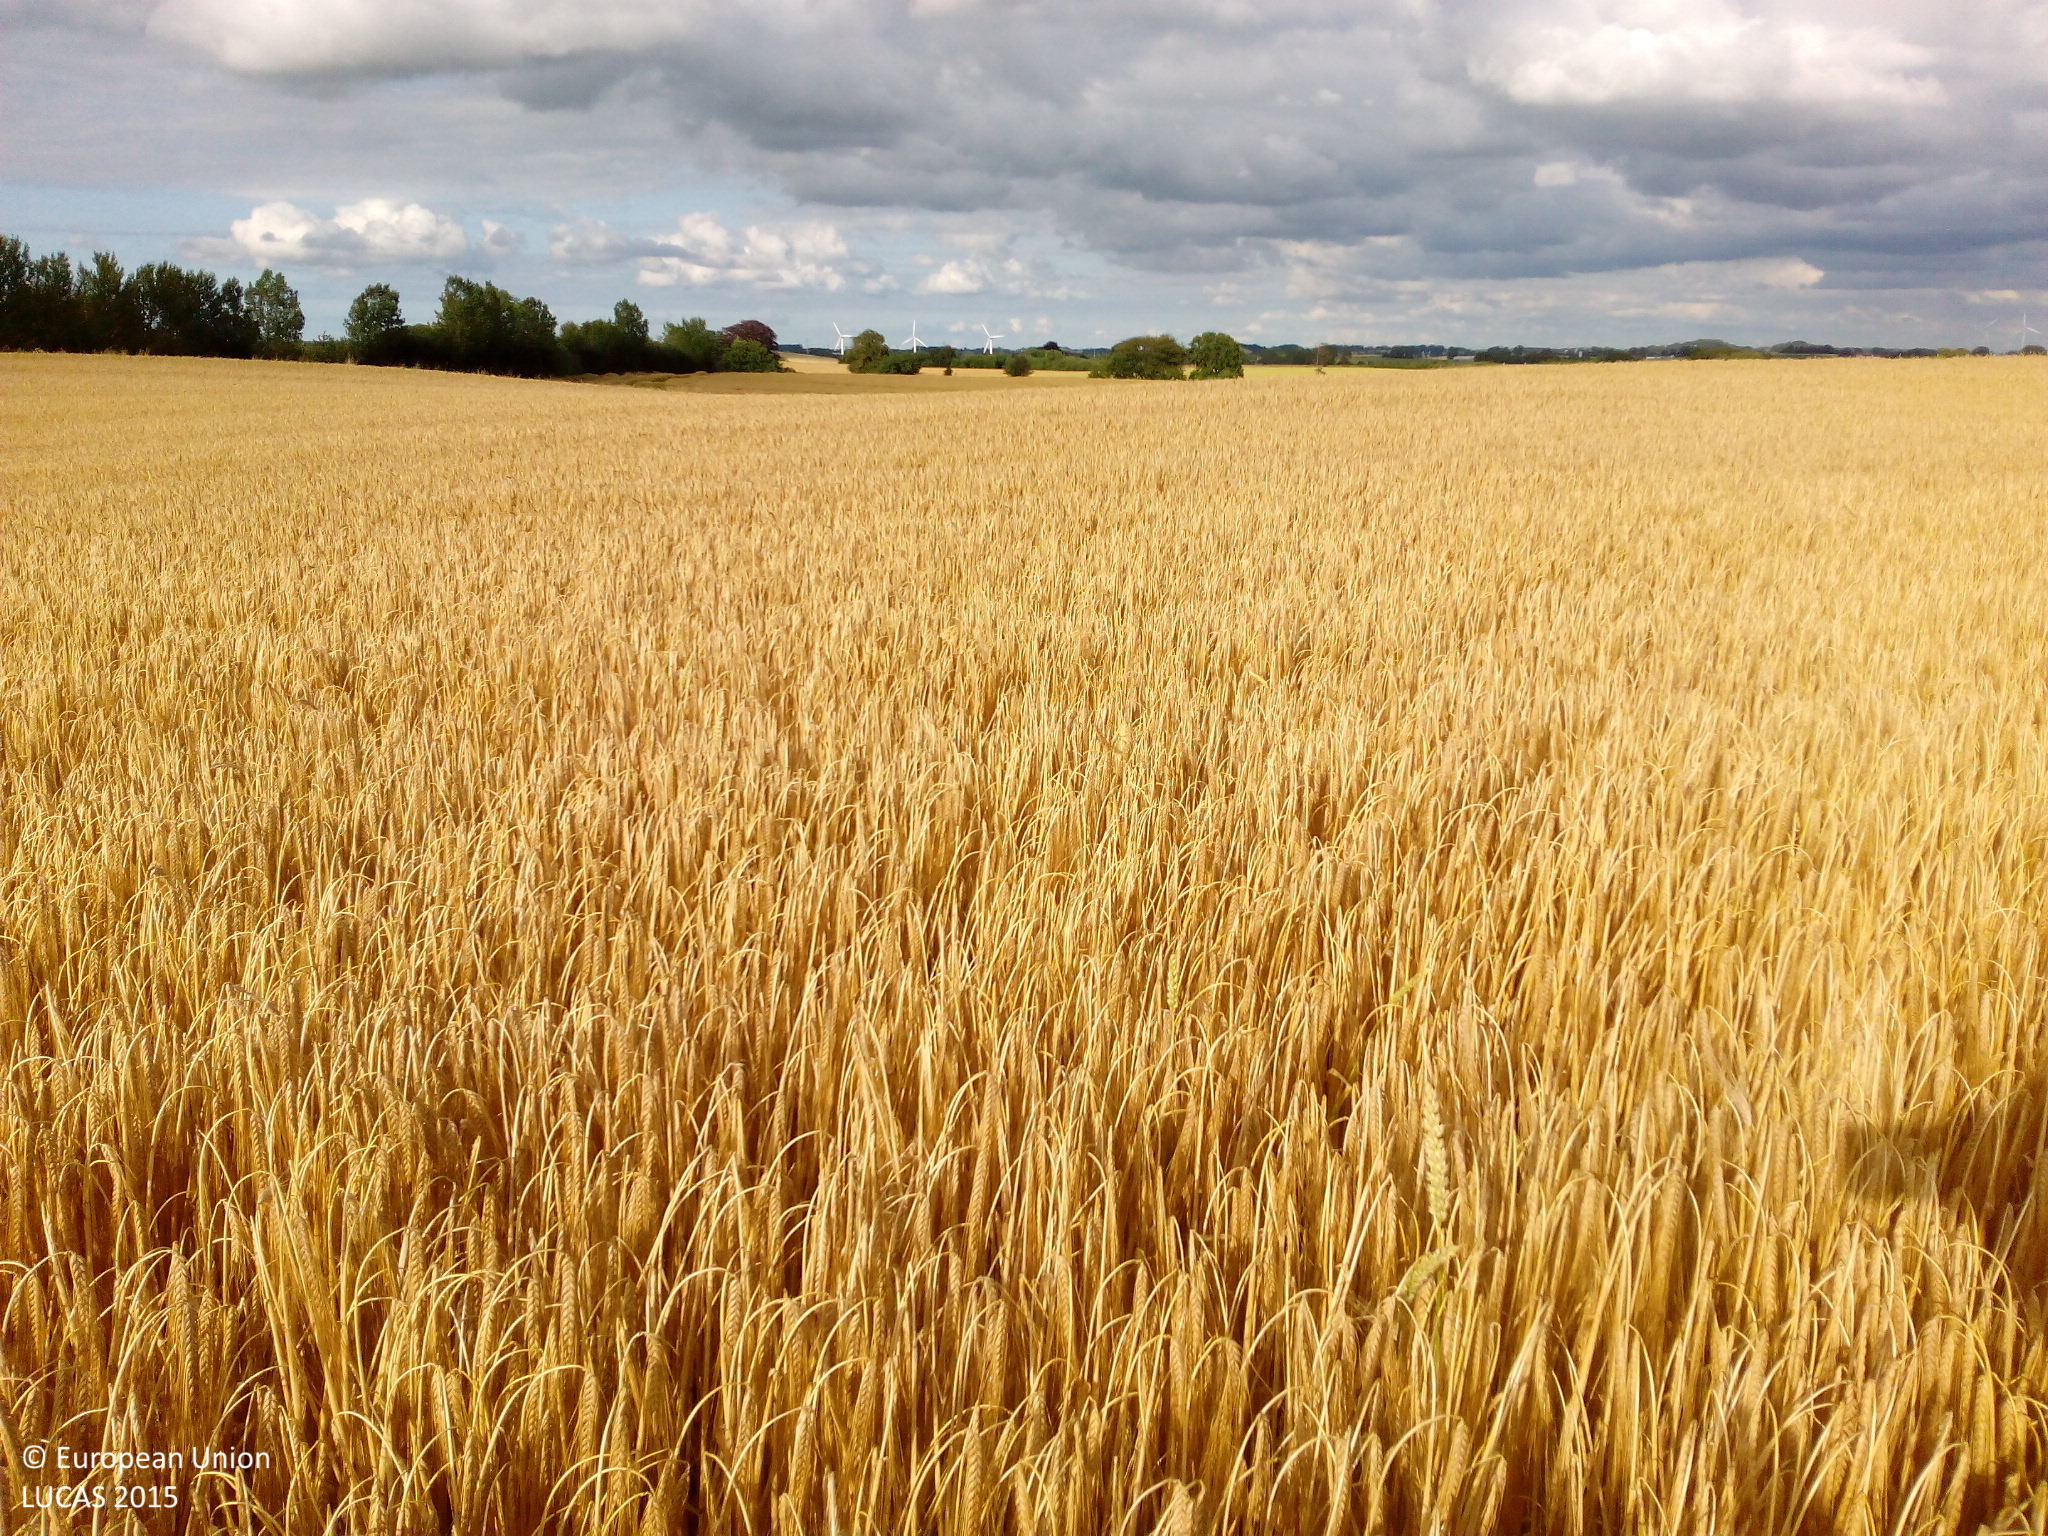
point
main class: Cropland
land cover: Barley
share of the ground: > 75 %
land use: Agriculture (excluding fallow land and kitchen gardens)
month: July
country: DK
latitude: 55.6945
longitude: 11.4146
